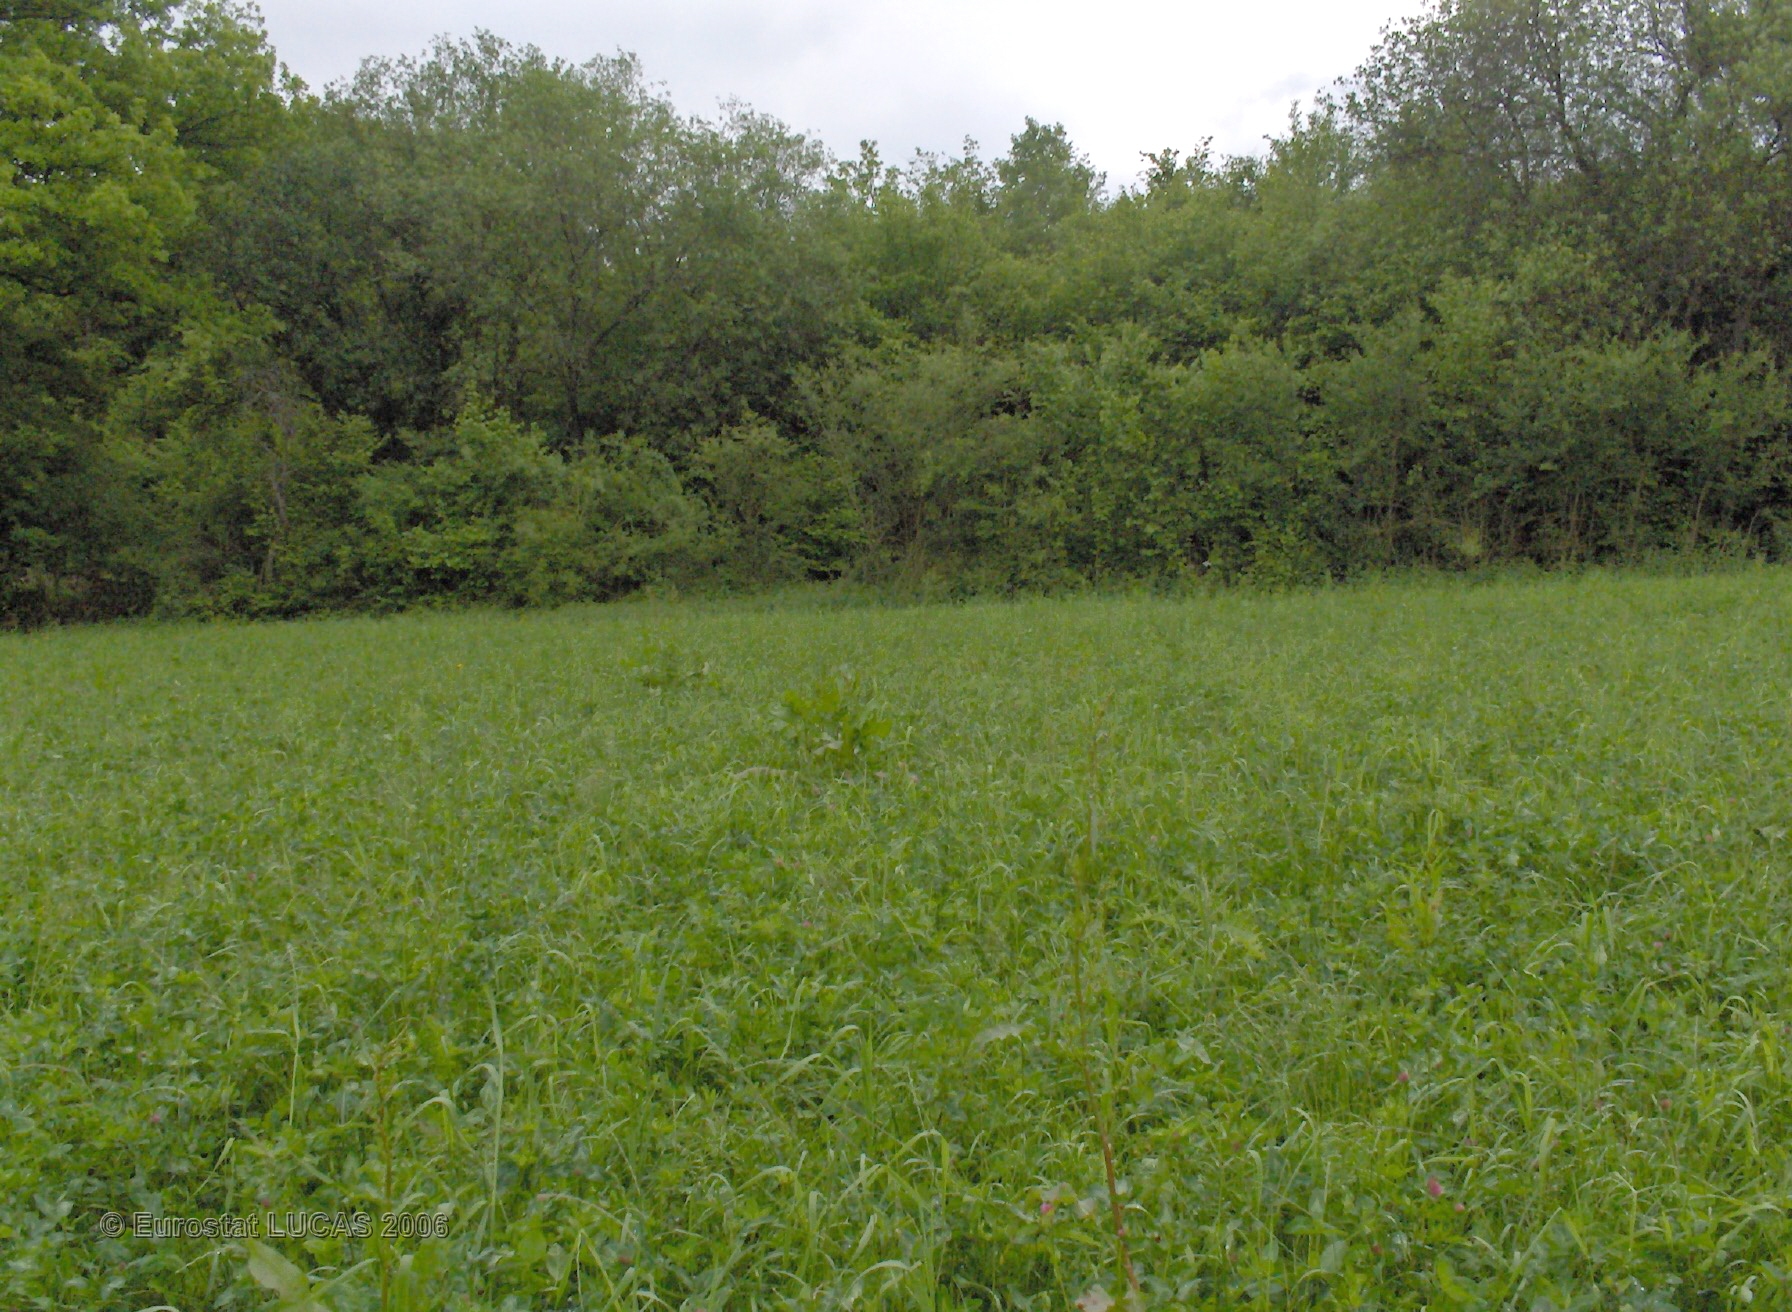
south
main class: Grassland
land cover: Grassland without tree/shrub cover
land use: Agriculture (excluding fallow land and kitchen gardens)
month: June
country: BE
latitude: 50.1634
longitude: 4.5786
